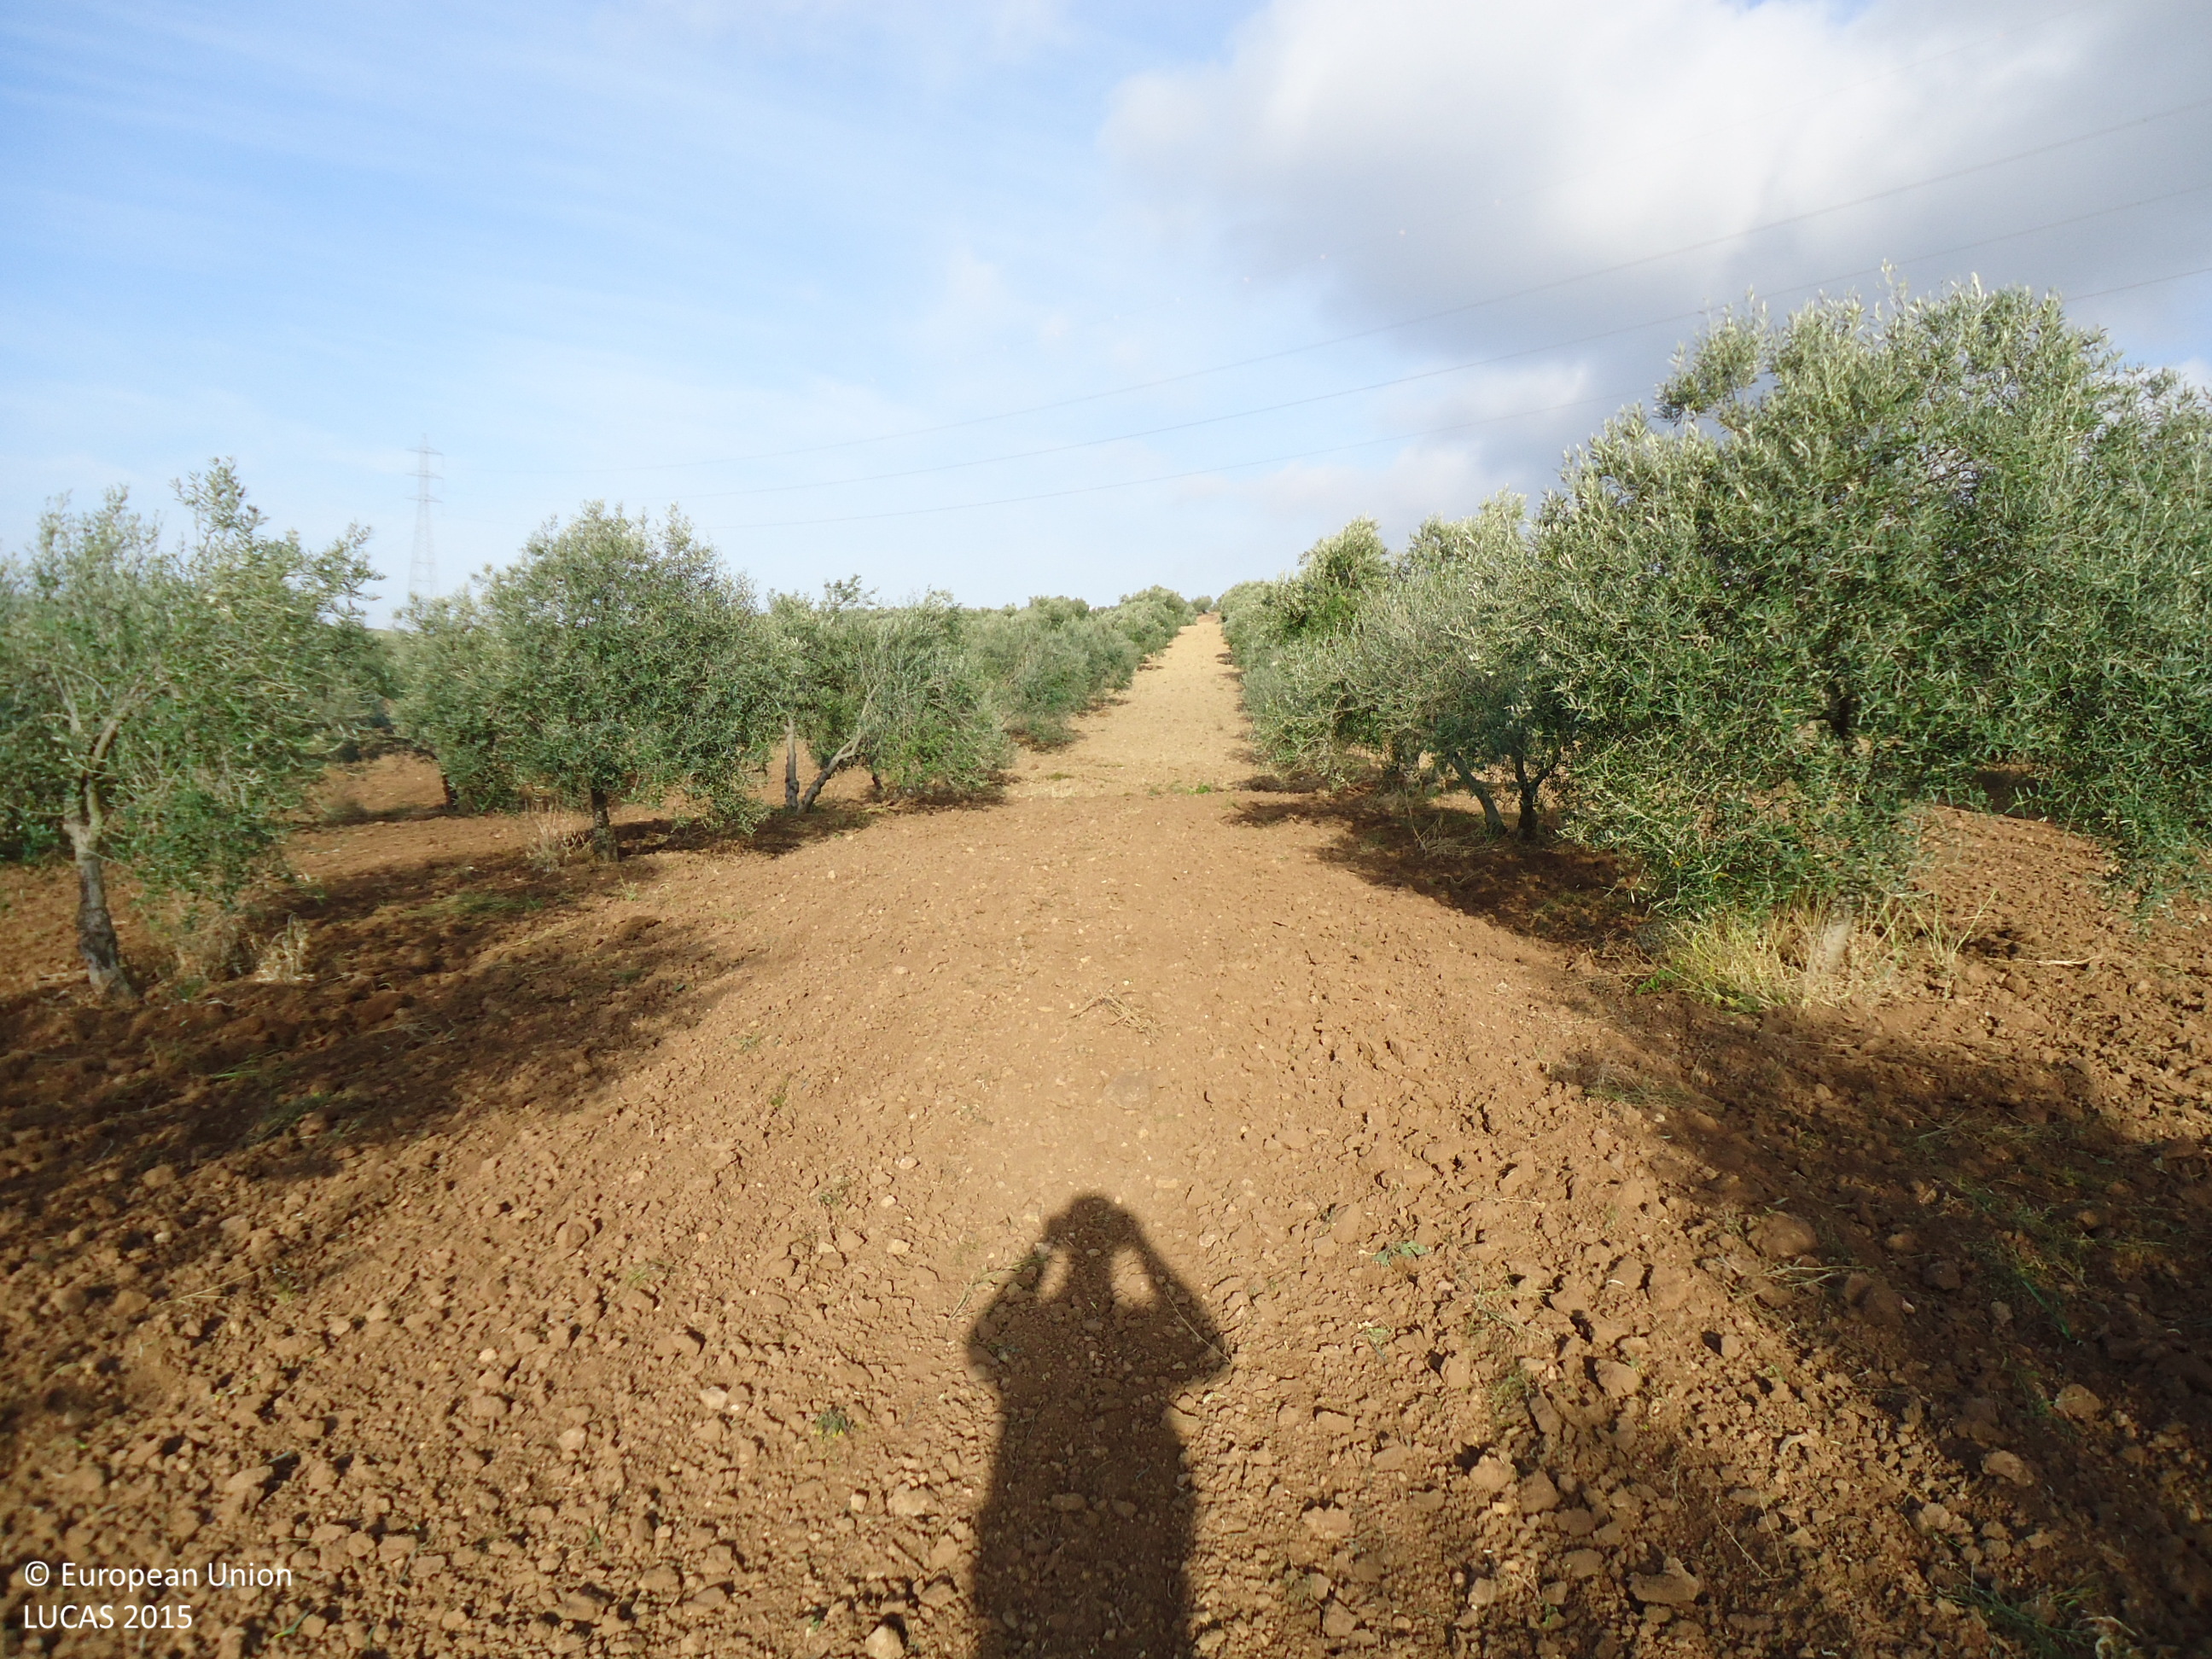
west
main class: Cropland
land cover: Olive groves
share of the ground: 25 - 50 %
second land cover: Other bare soil
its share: > 75 %
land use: Agriculture (excluding fallow land and kitchen gardens)
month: April
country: ES
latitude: 37.2015
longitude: -4.8418
